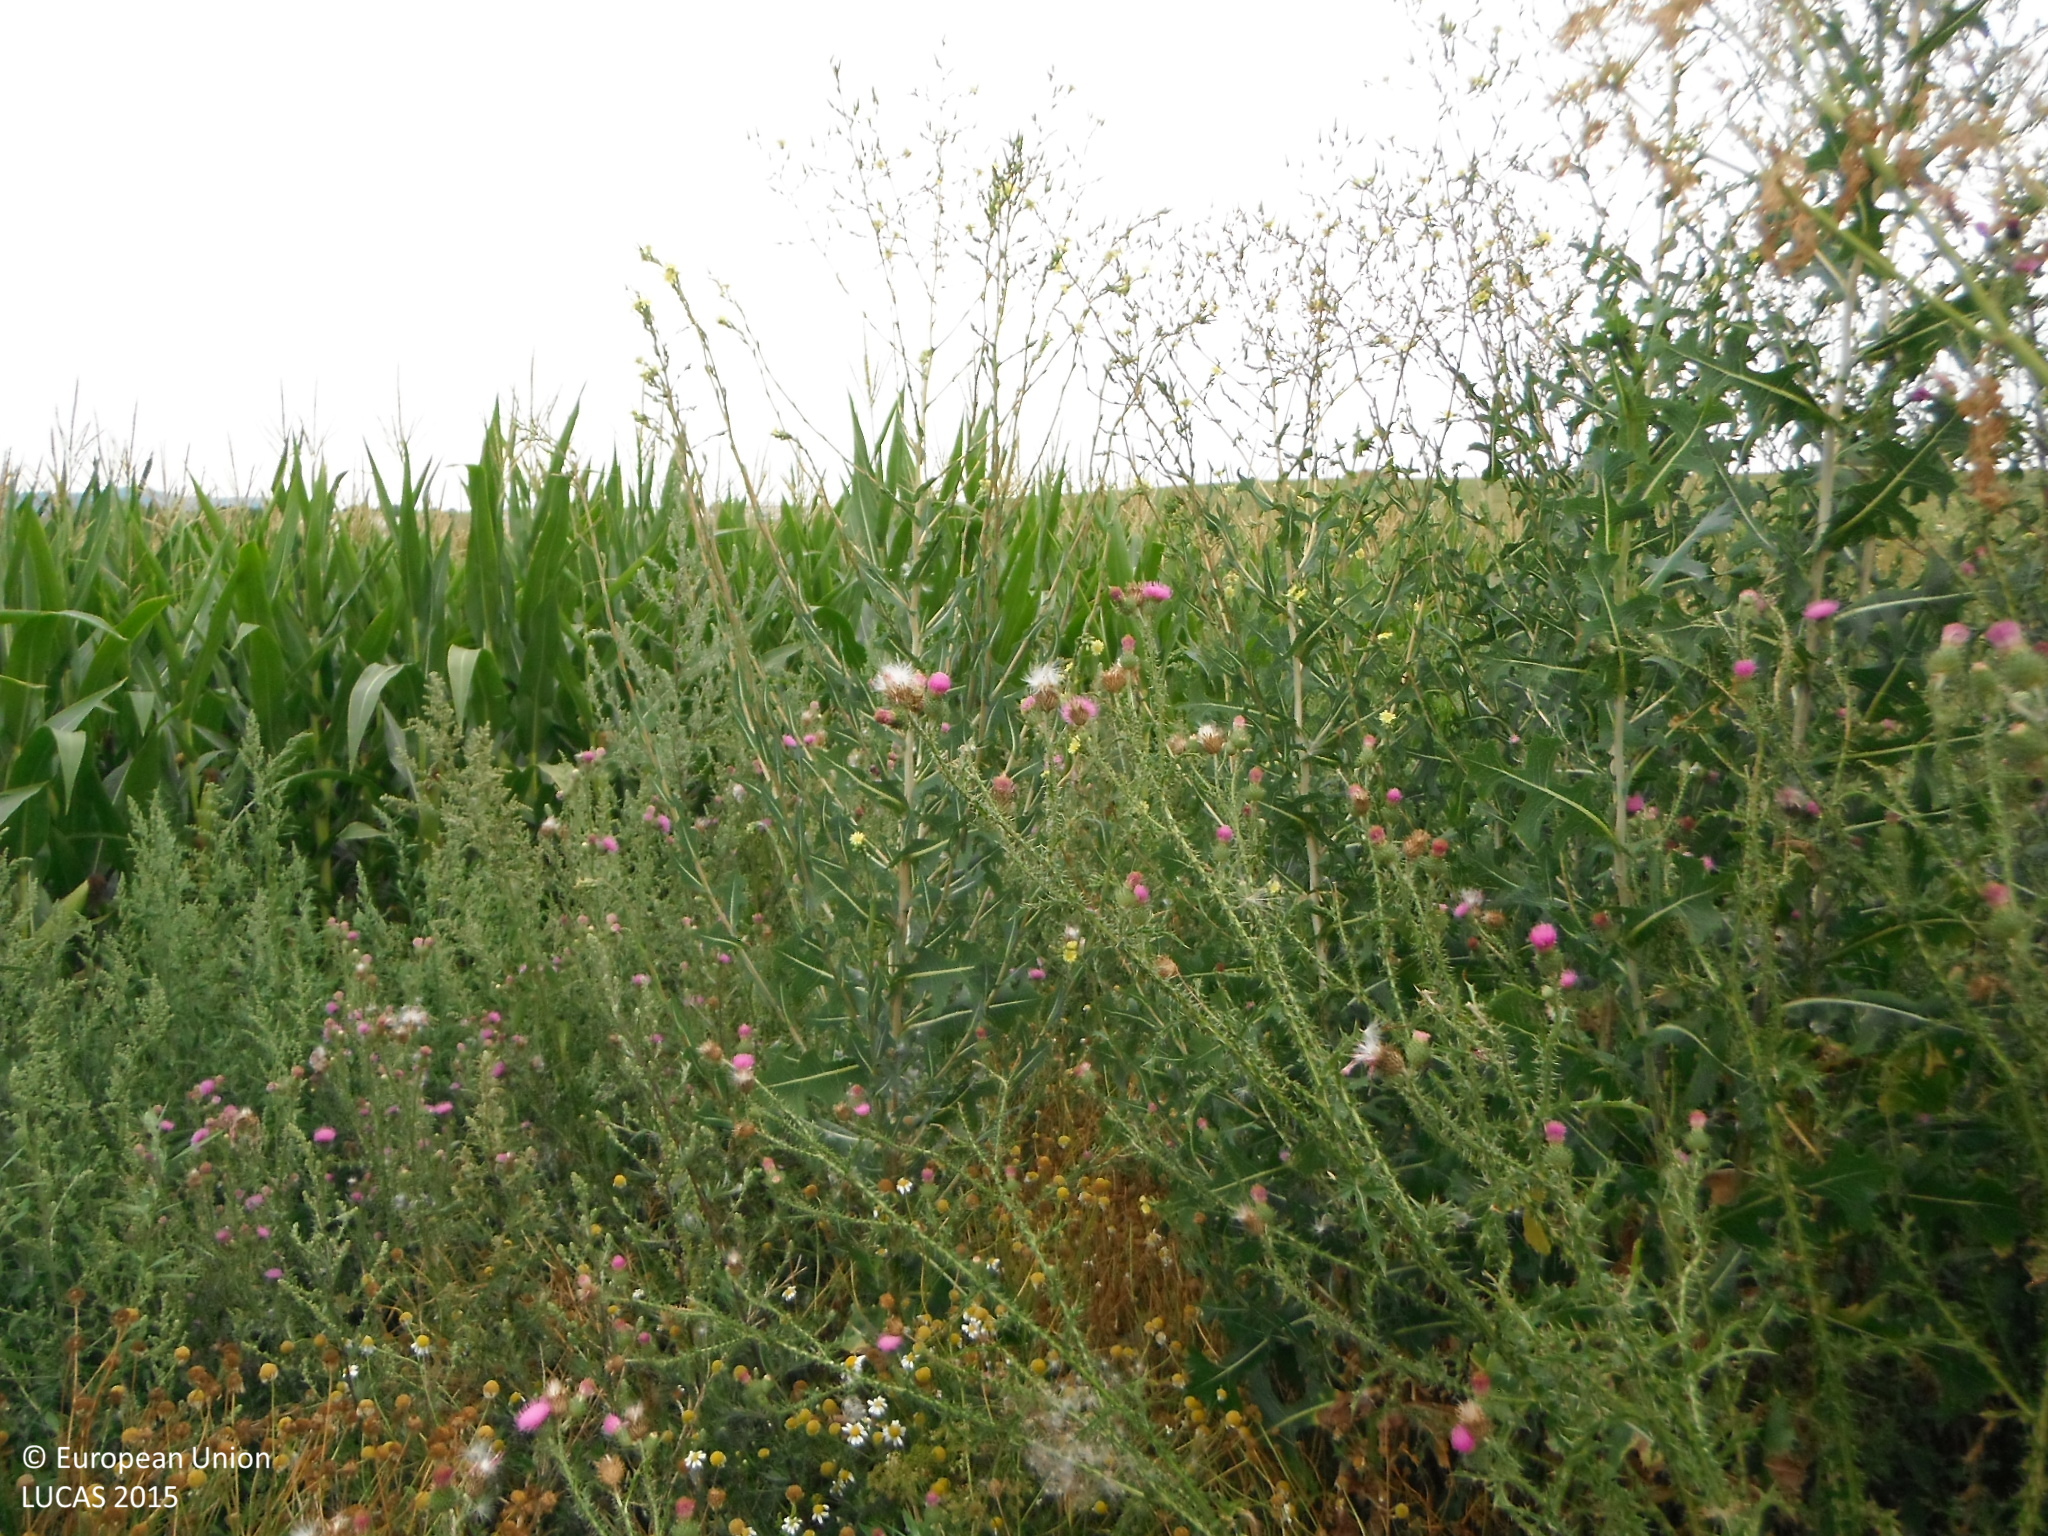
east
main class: Cropland
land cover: Maize
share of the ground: > 75 %
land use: Agriculture (excluding fallow land and kitchen gardens)
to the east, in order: Maize
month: July
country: SK
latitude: 48.6709
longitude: 18.2856
